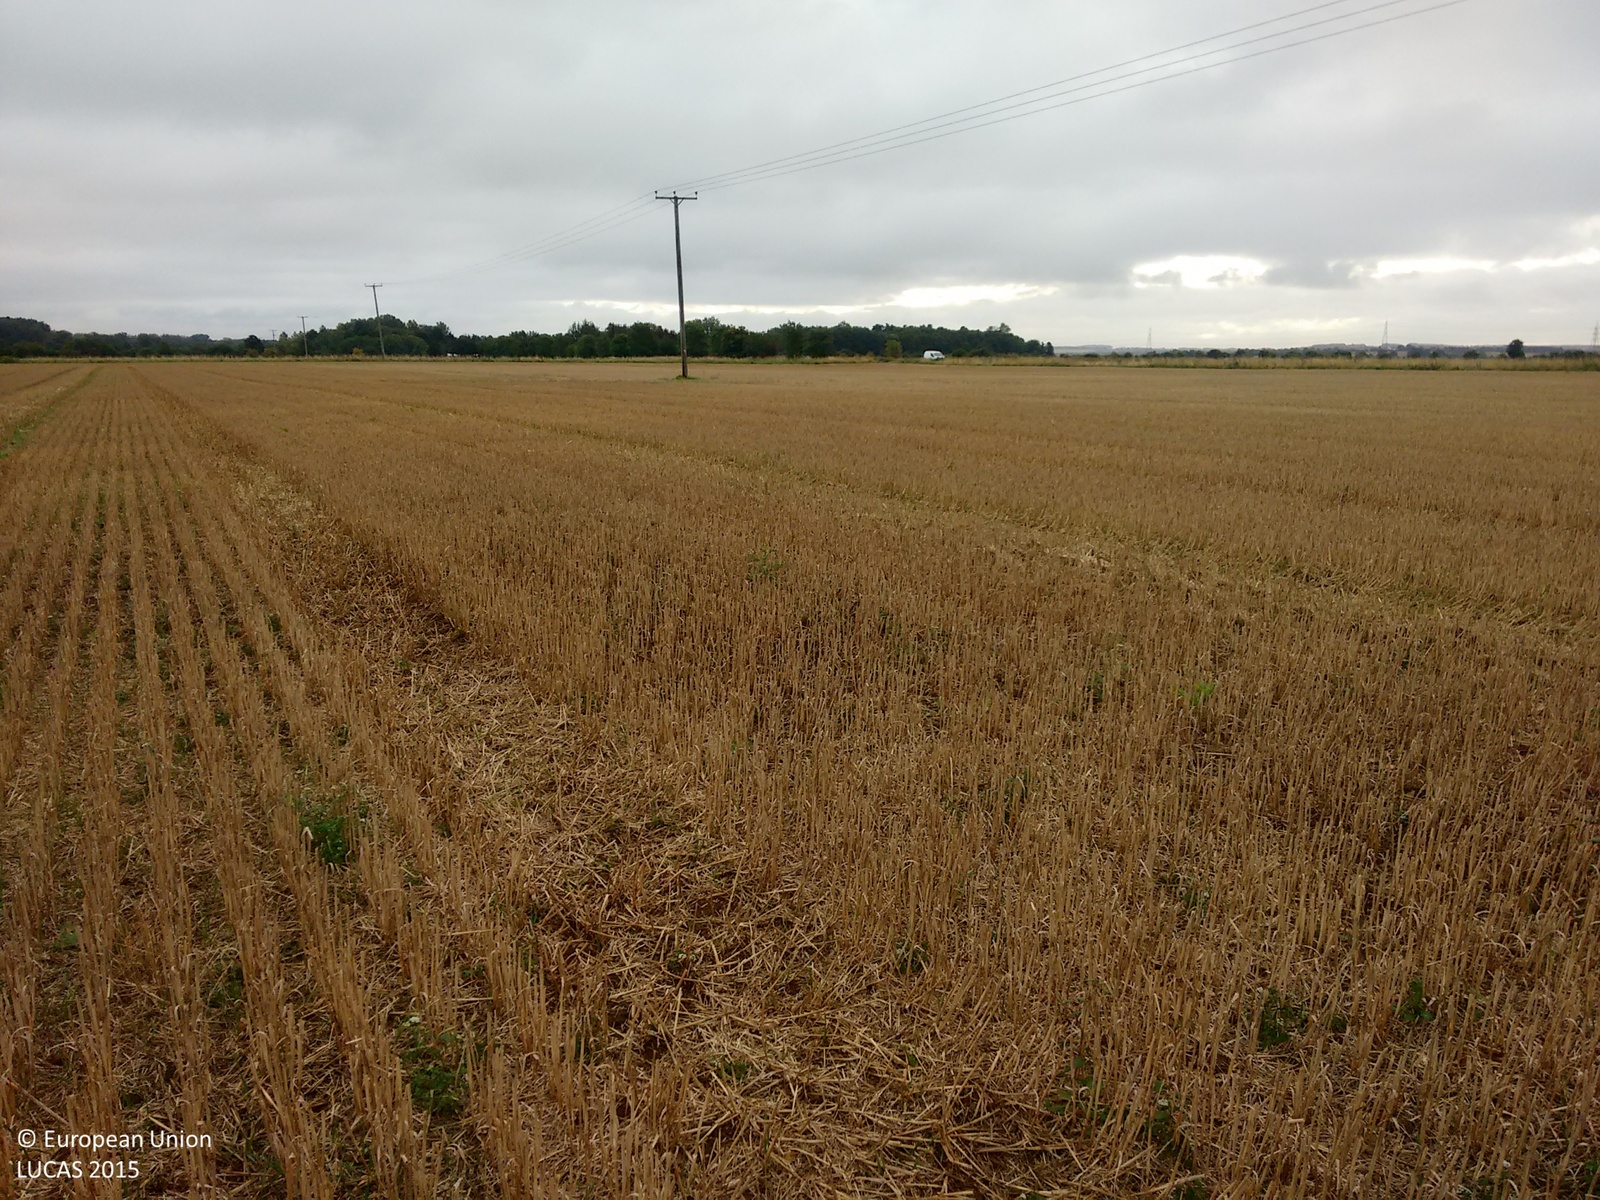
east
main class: Cropland
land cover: Common wheat
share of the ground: > 75 %
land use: Agriculture (excluding fallow land and kitchen gardens)
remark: Harvested field
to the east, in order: Common wheat; Electric lines; Common wheat; Grass margins; Ditches and canals; Grass margins; Single bushes/trees; Ditches and canals; Grass margins; Paved roads, cycling and walking lanes
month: September
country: GB
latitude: 52.1919
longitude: 0.2418
